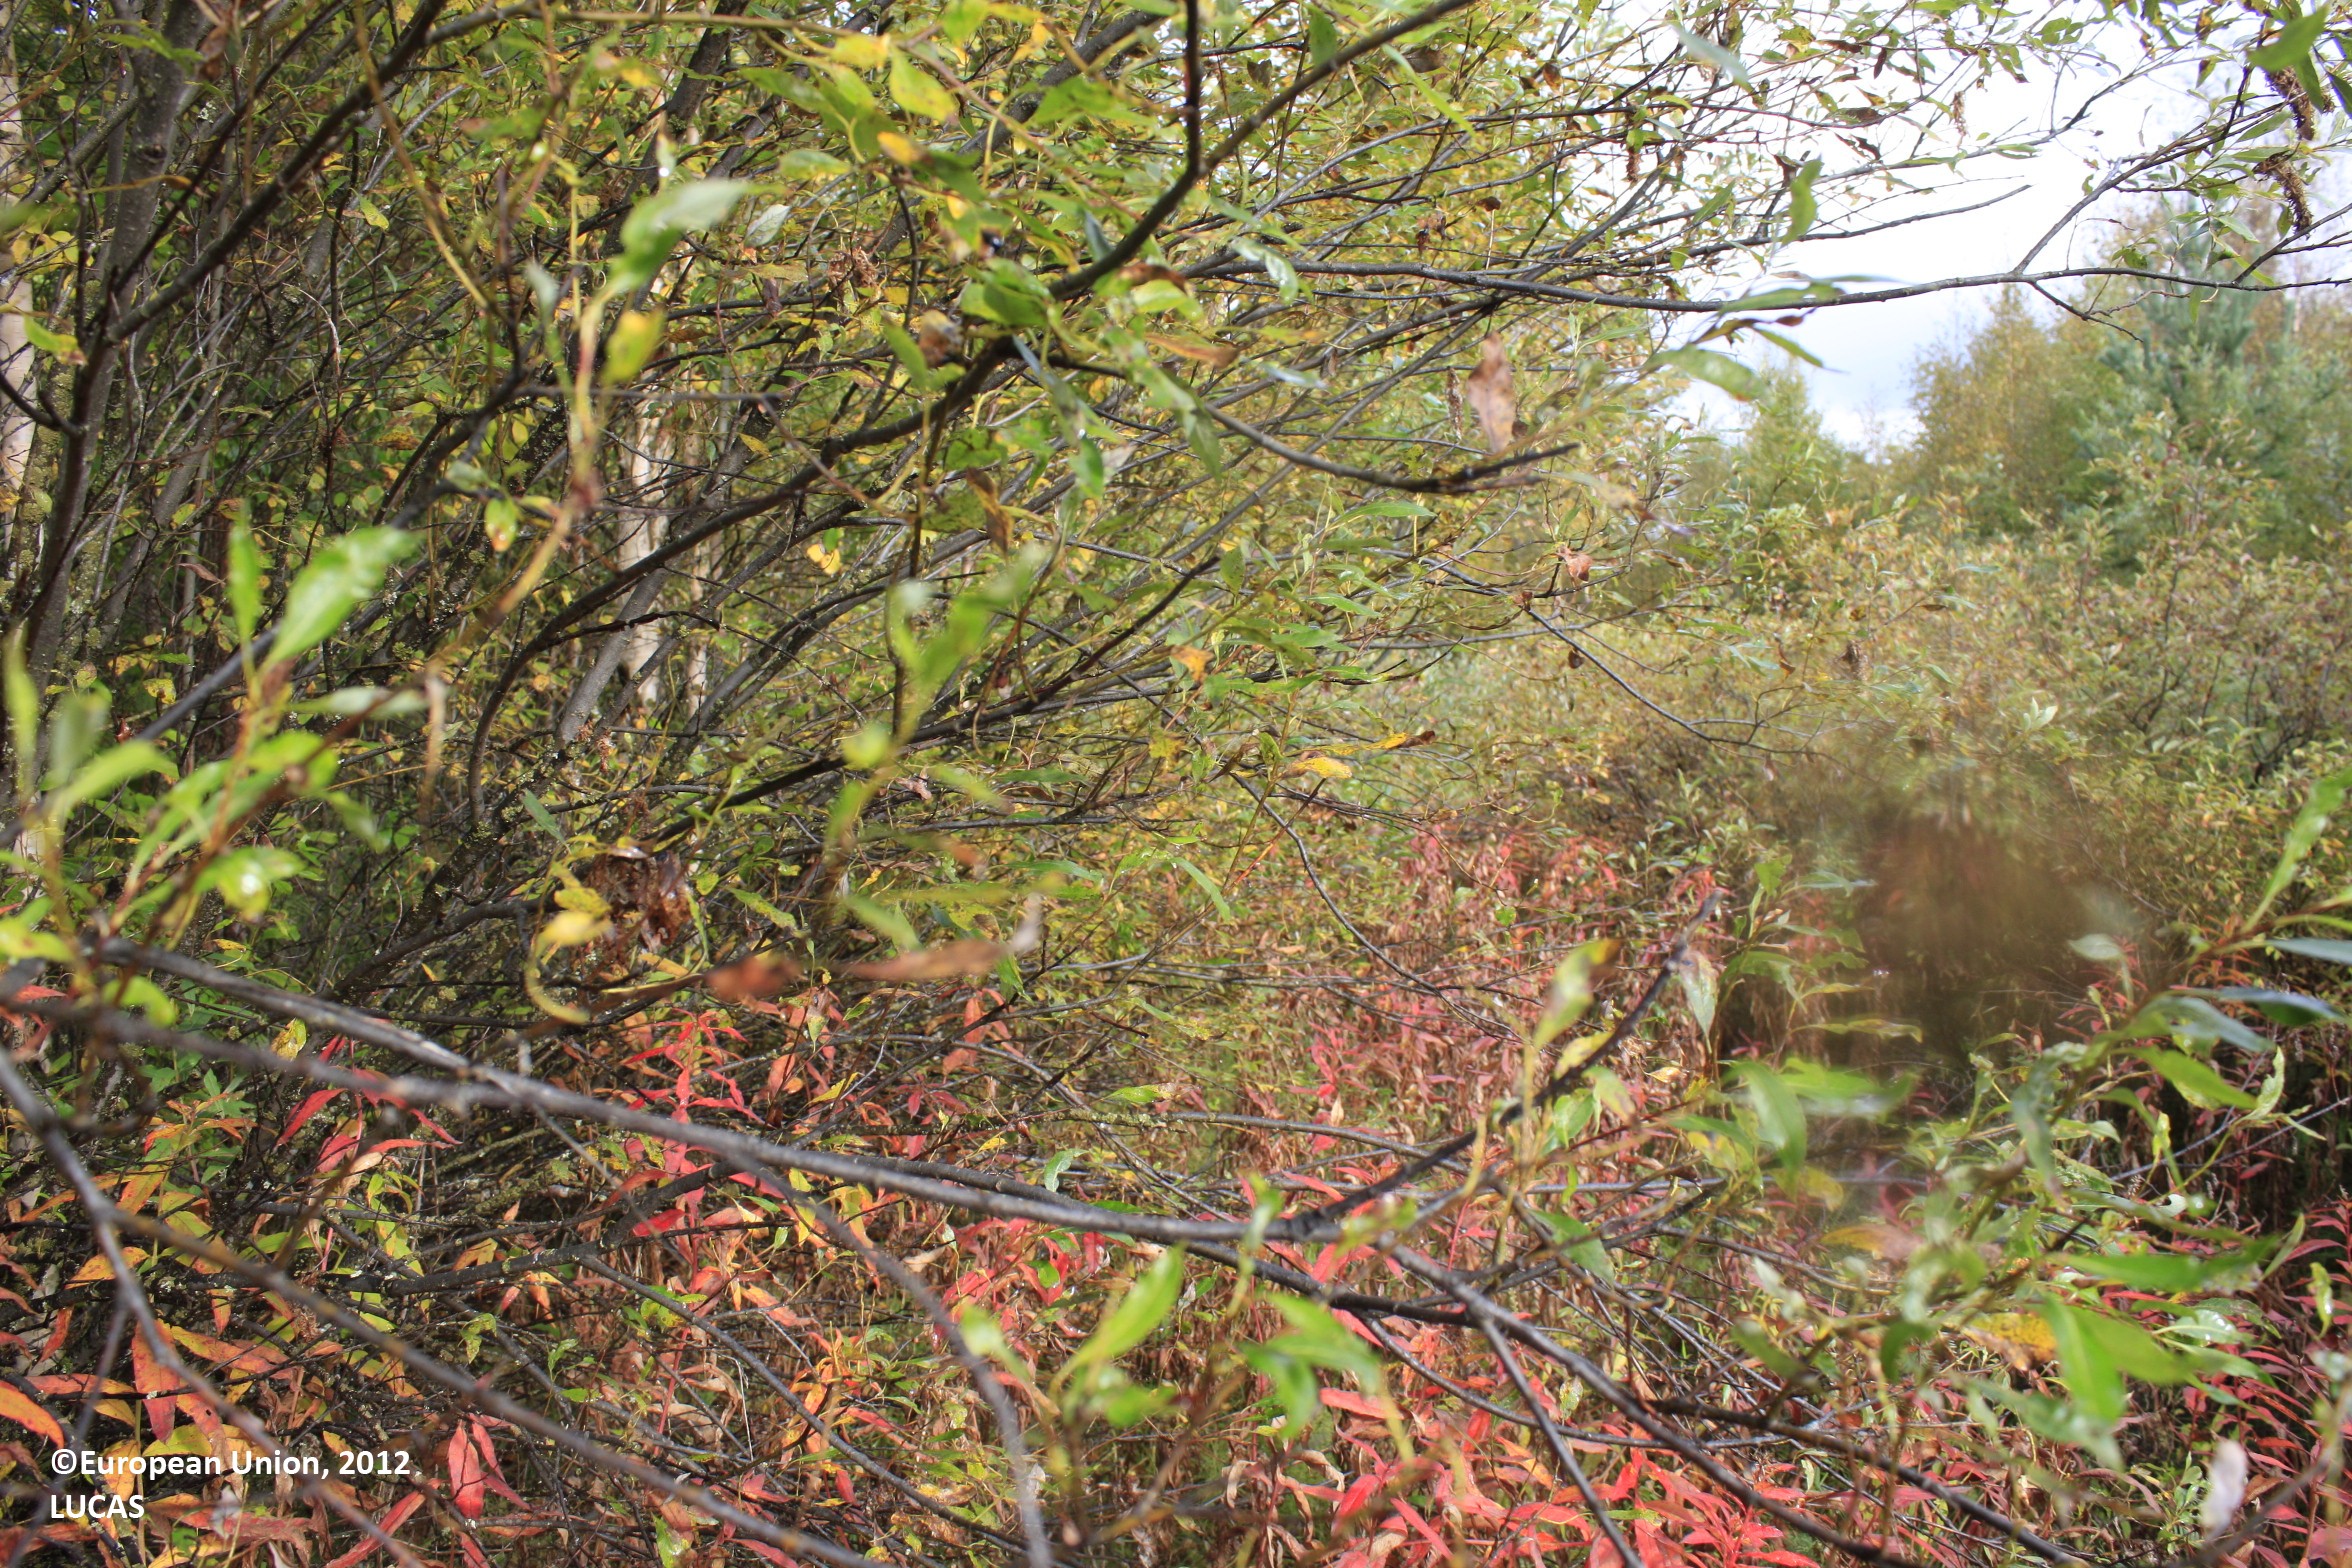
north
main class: Shrubland
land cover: Shrubland with sparse tree cover
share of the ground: > 75 %
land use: Semi-natural and natural areas not in use
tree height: > 5 m
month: September
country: FI
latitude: 65.5755
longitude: 26.5966
